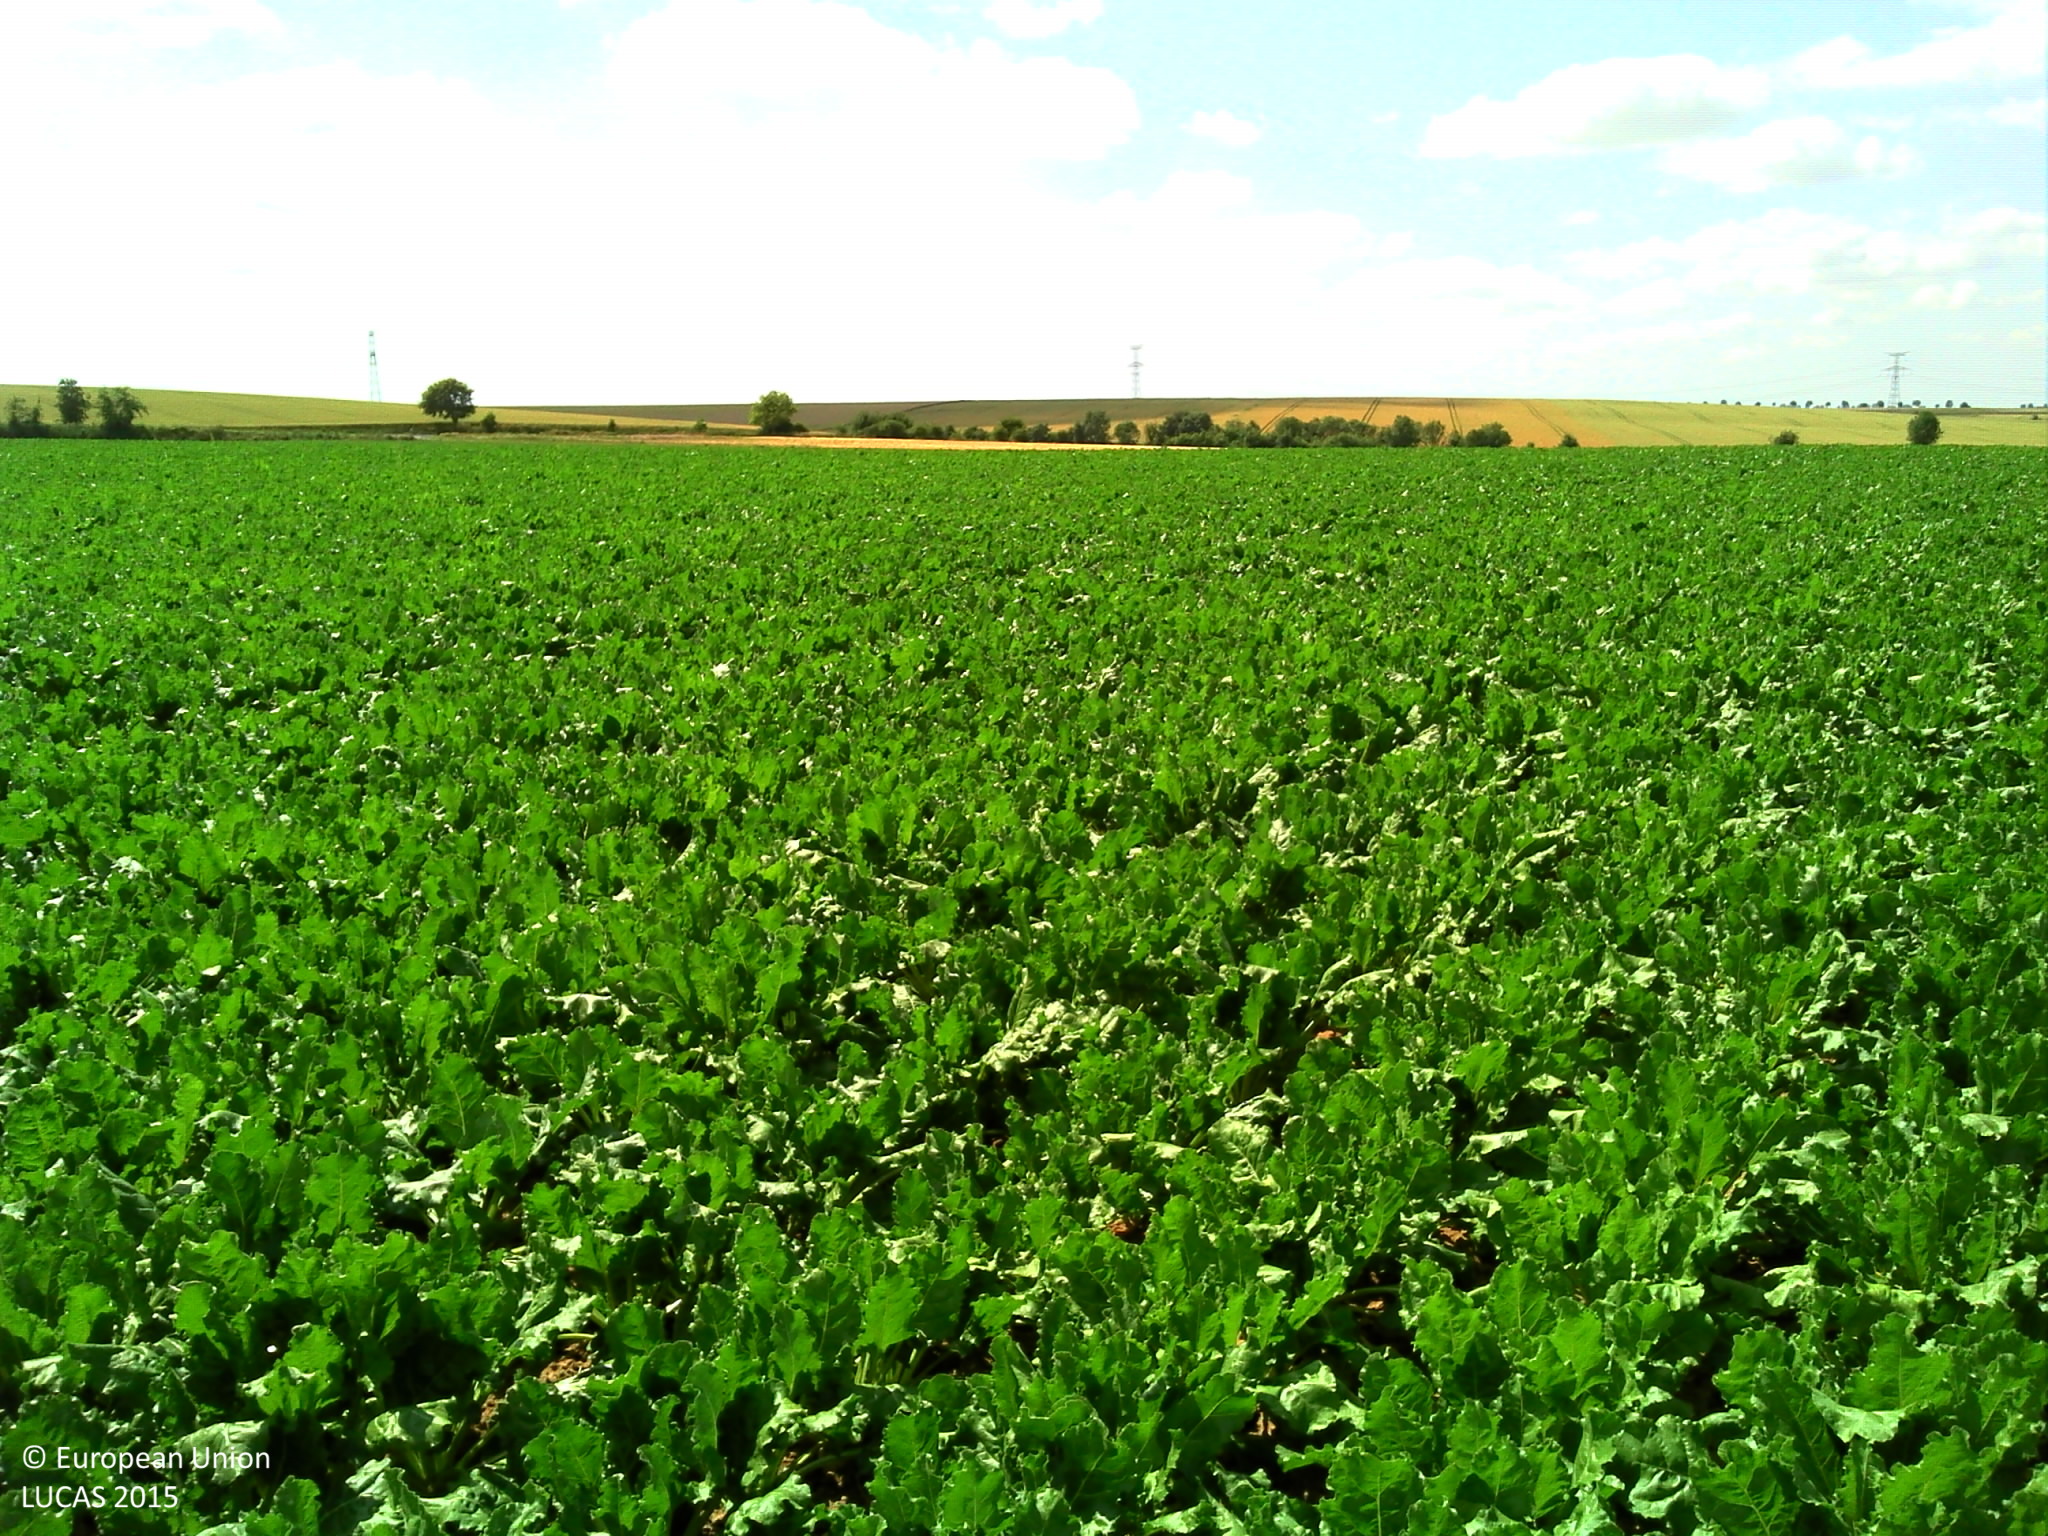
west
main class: Cropland
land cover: Sugar beet
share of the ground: > 75 %
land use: Agriculture (excluding fallow land and kitchen gardens)
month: July
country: FR
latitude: 50.2939
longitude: 2.1667
